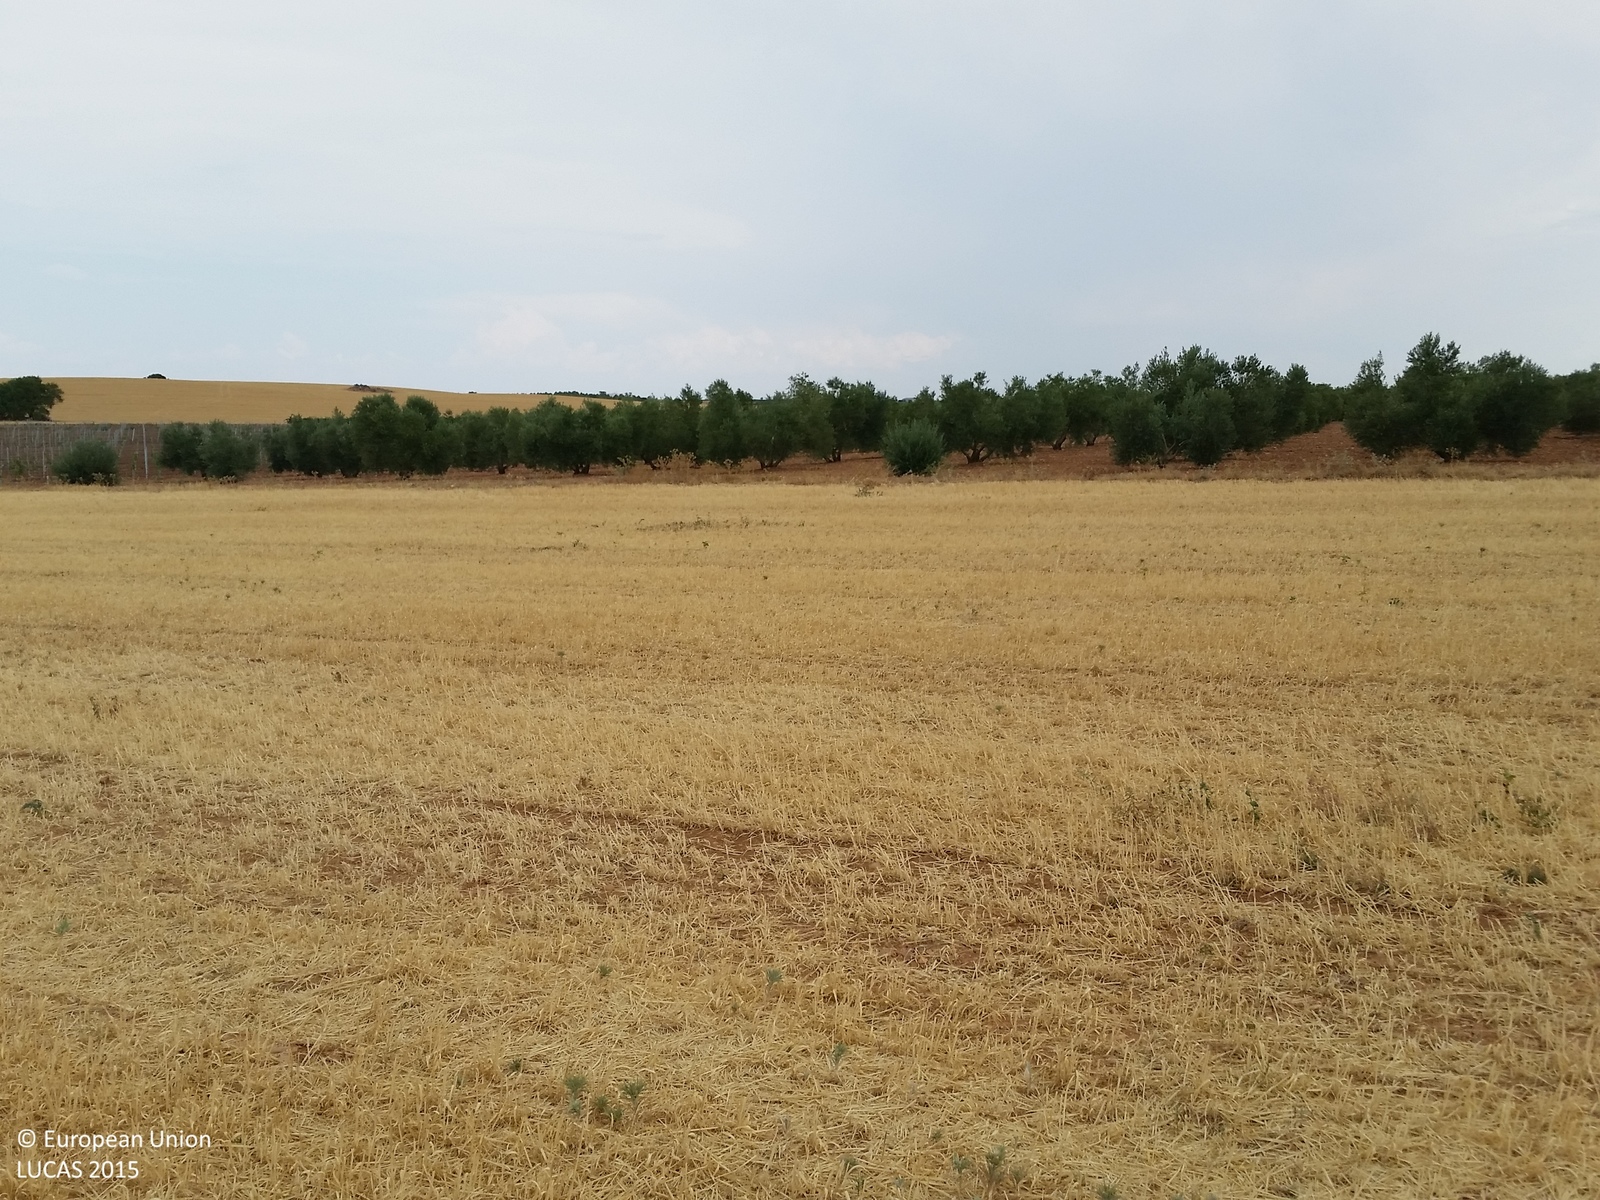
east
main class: Cropland
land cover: Barley
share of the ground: < 10 %
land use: Agriculture (excluding fallow land and kitchen gardens)
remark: Harvested field
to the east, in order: Barley; Olive groves; Vineyards
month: July
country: ES
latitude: 39.1840
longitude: -2.6863
